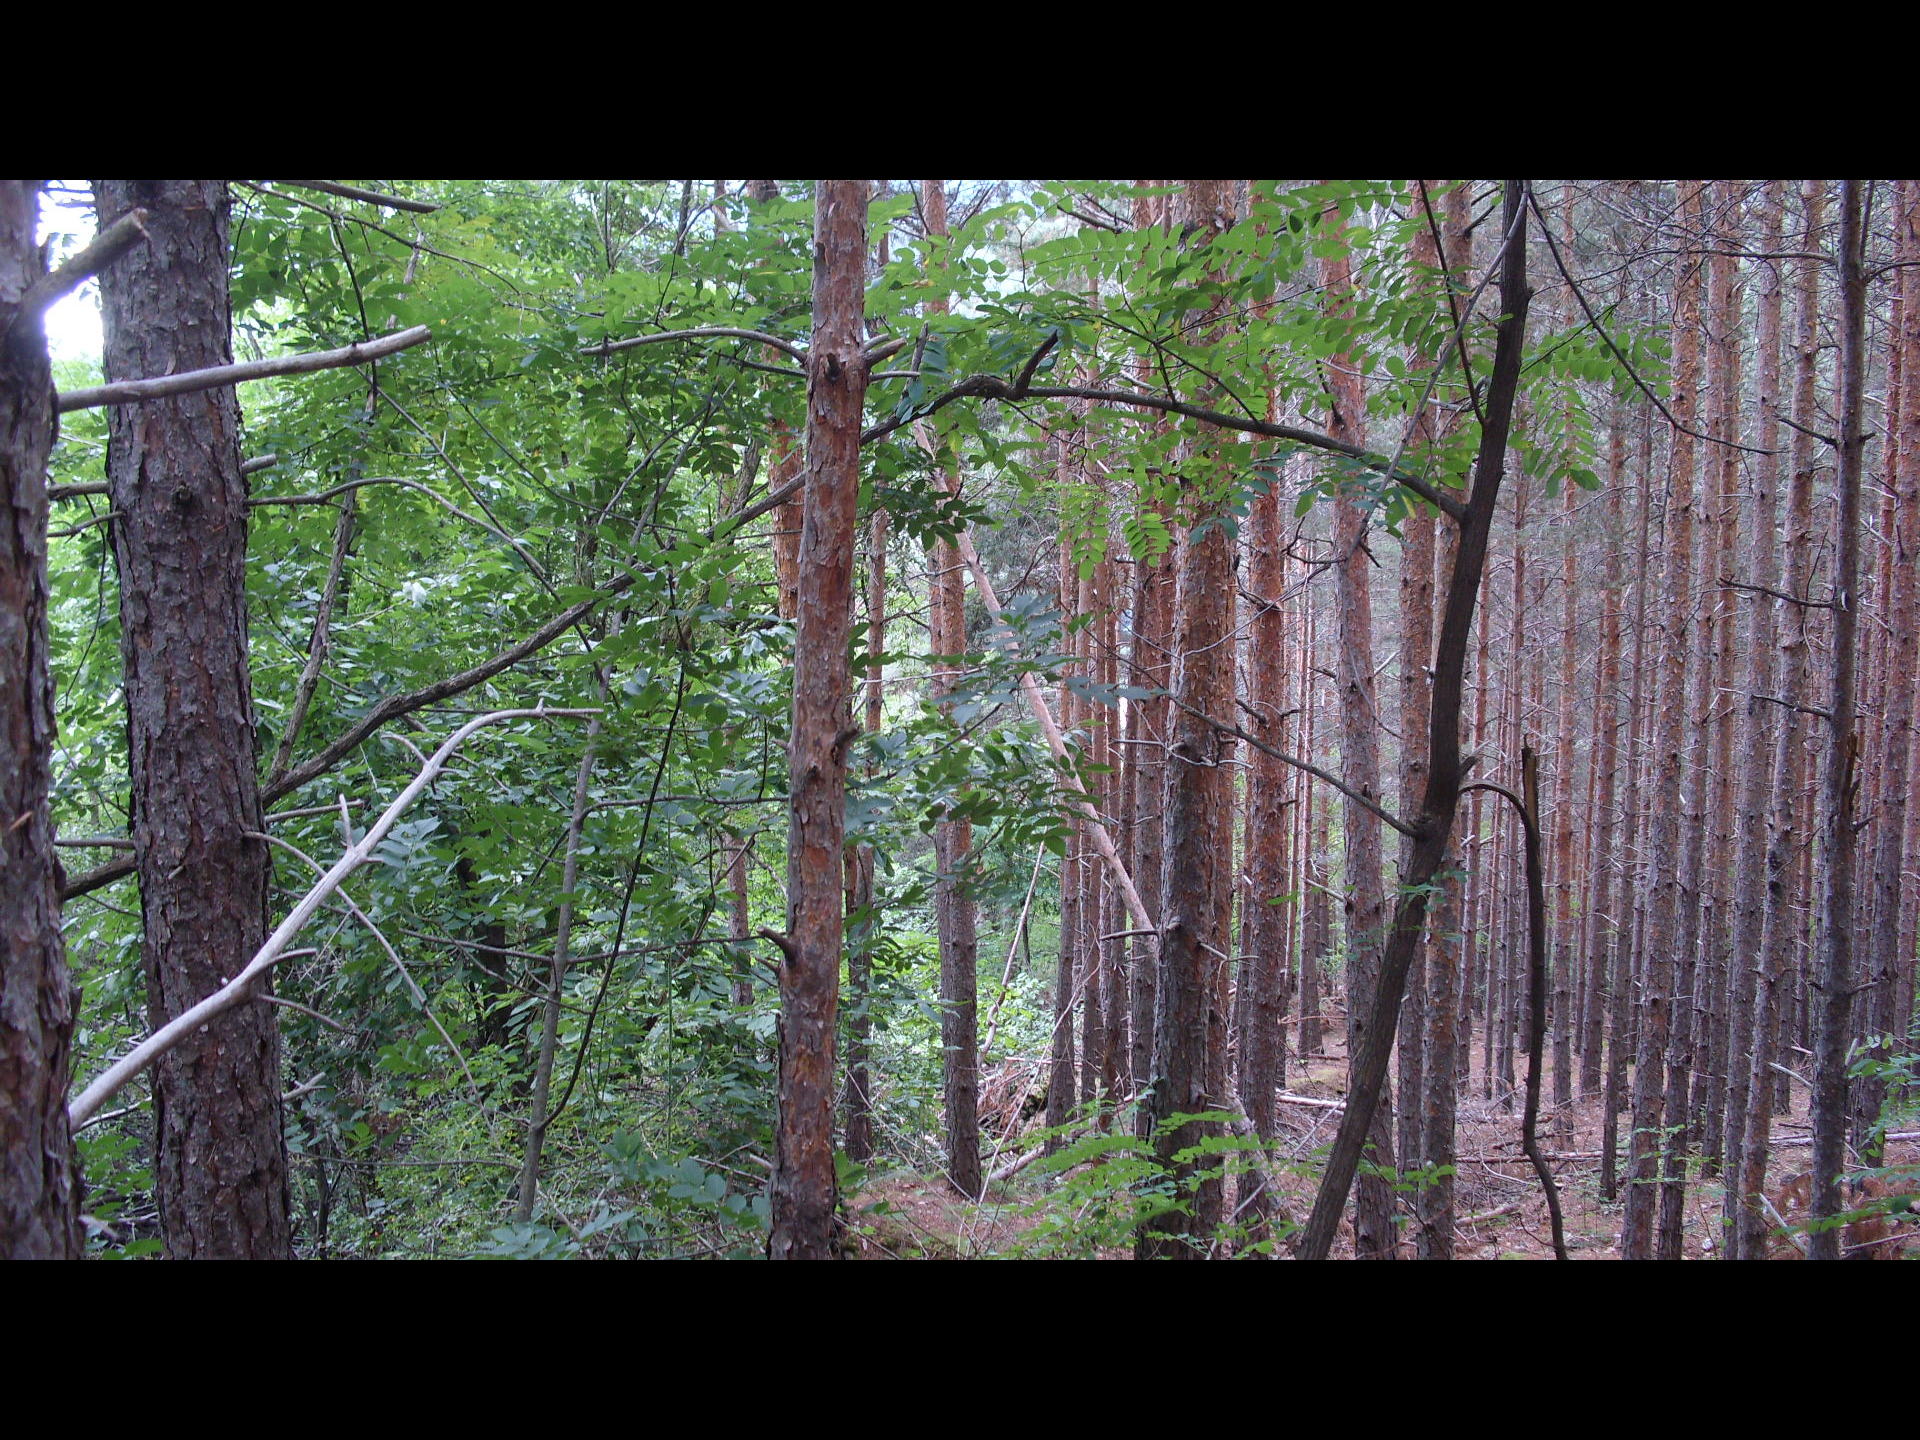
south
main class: Woodland
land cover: Other mixed woodland
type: hemiboreal forest and nemoral coniferous forest and mixed broadleaved-coniferous forest
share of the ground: > 75 %
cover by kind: coniferous forest trees 75 %, broadleaved forest trees 25 %
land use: Forestry
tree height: > 5 m
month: October
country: BG
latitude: 43.4033
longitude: 22.8387
